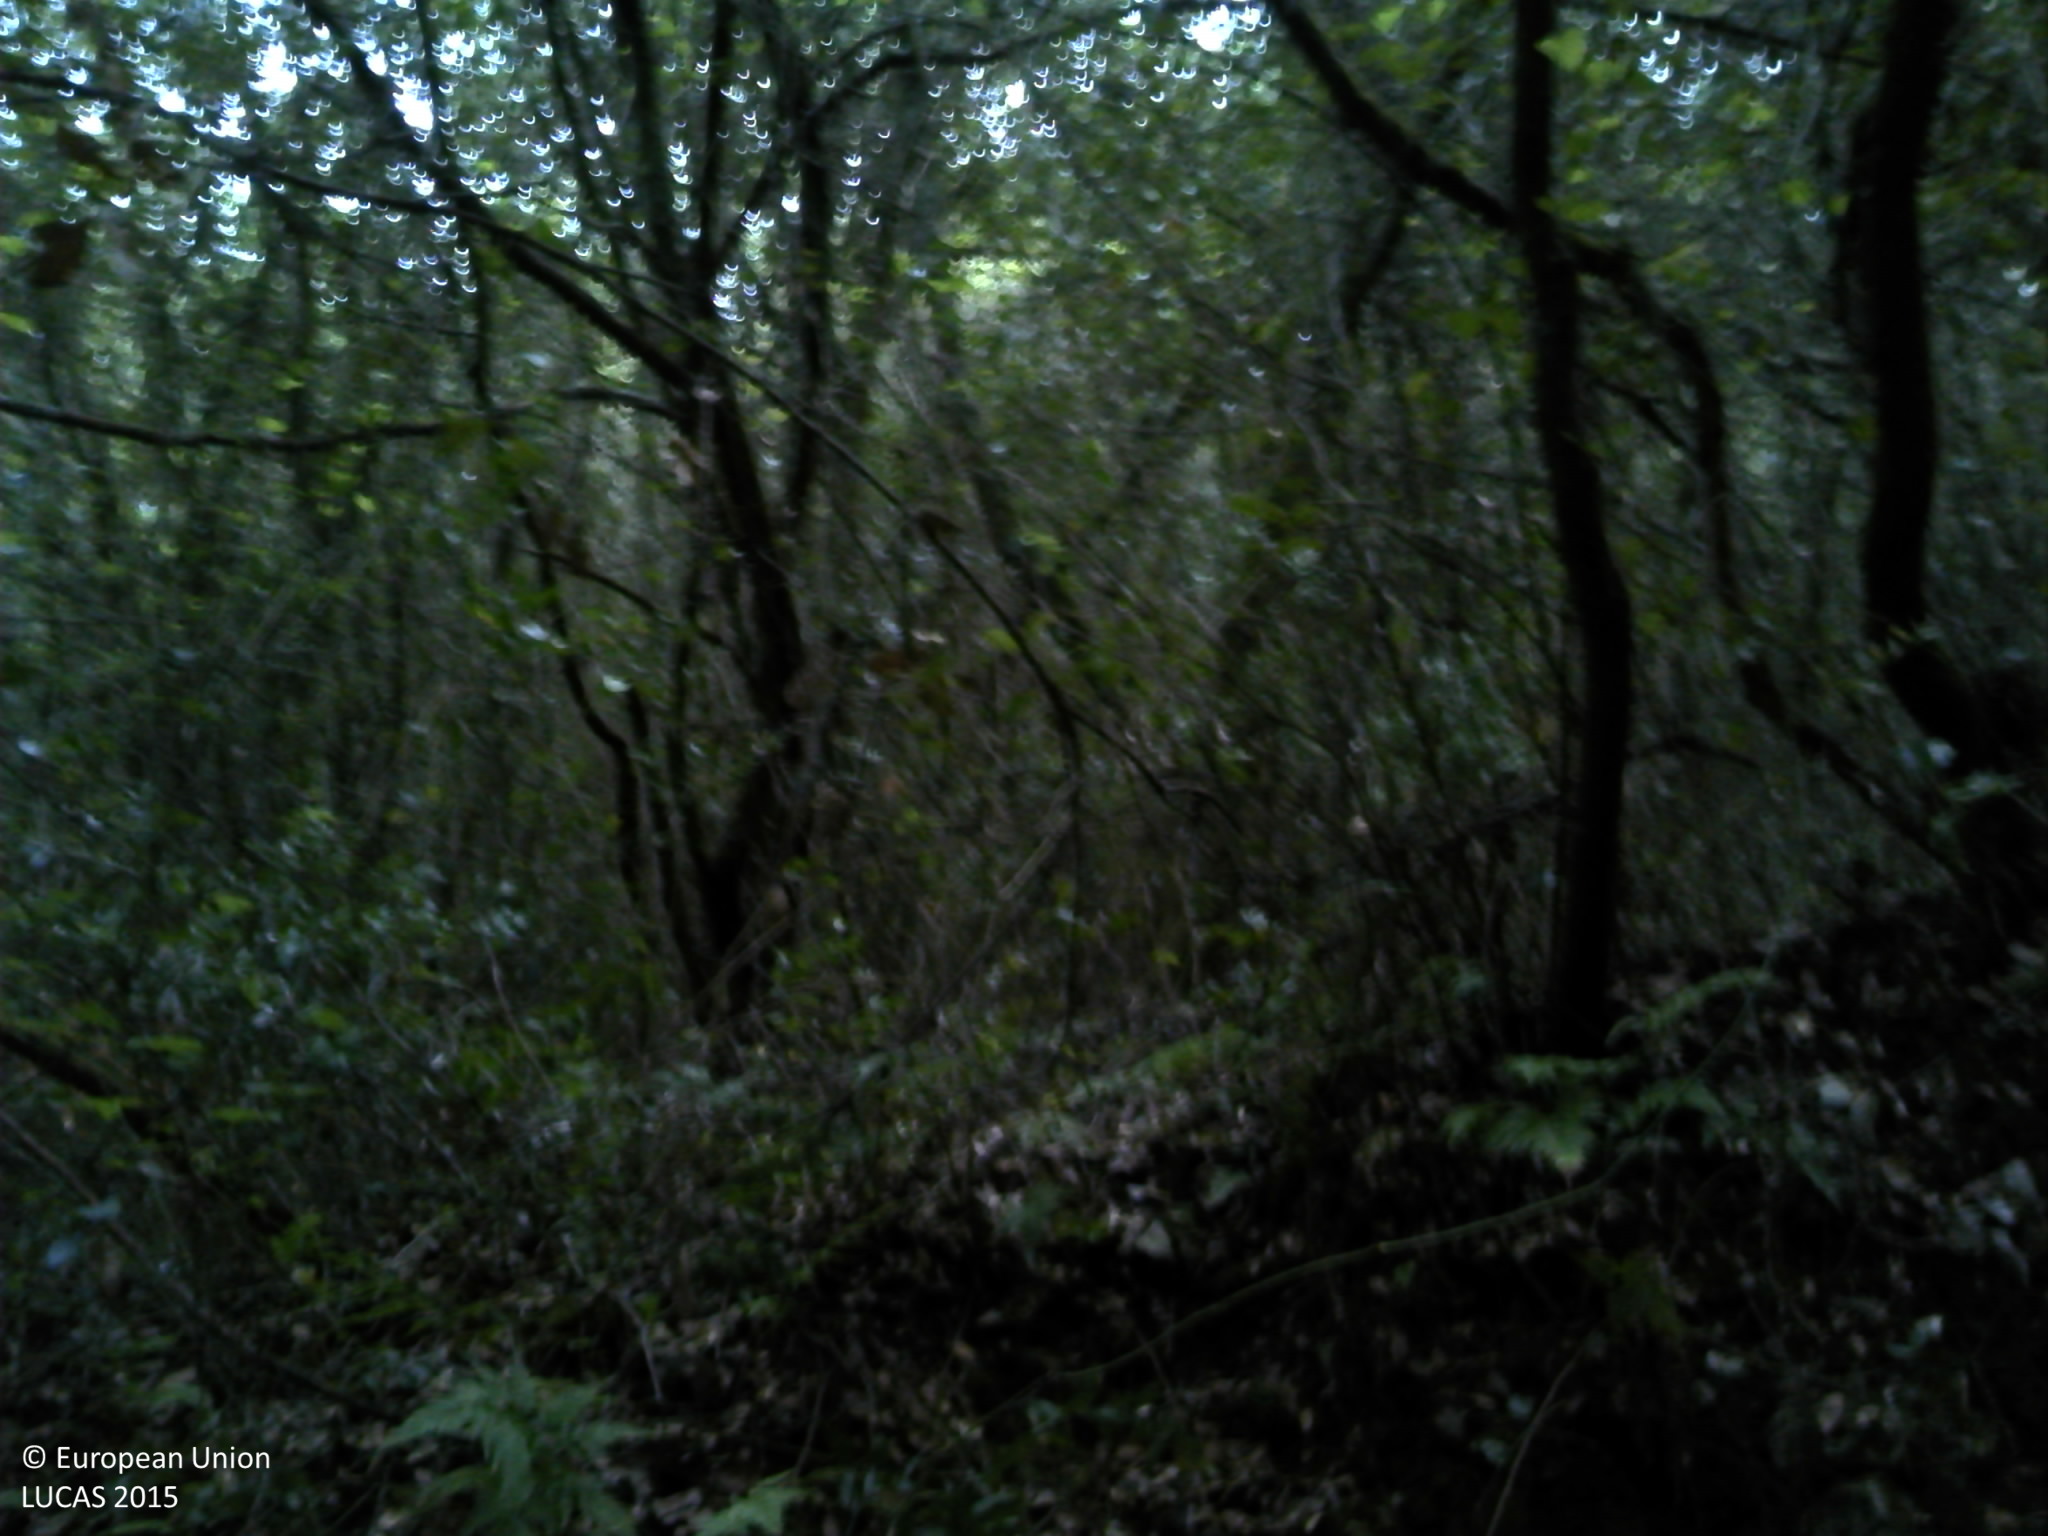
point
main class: Woodland
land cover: Broadleaved woodland
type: thermophilous deciduous forest
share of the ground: > 75 %
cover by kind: broadleaved forest trees 75 %, shrubs 25 %
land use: Semi-natural and natural areas not in use
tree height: < 5 m
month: June
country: PT
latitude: 39.0838
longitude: -9.2411
